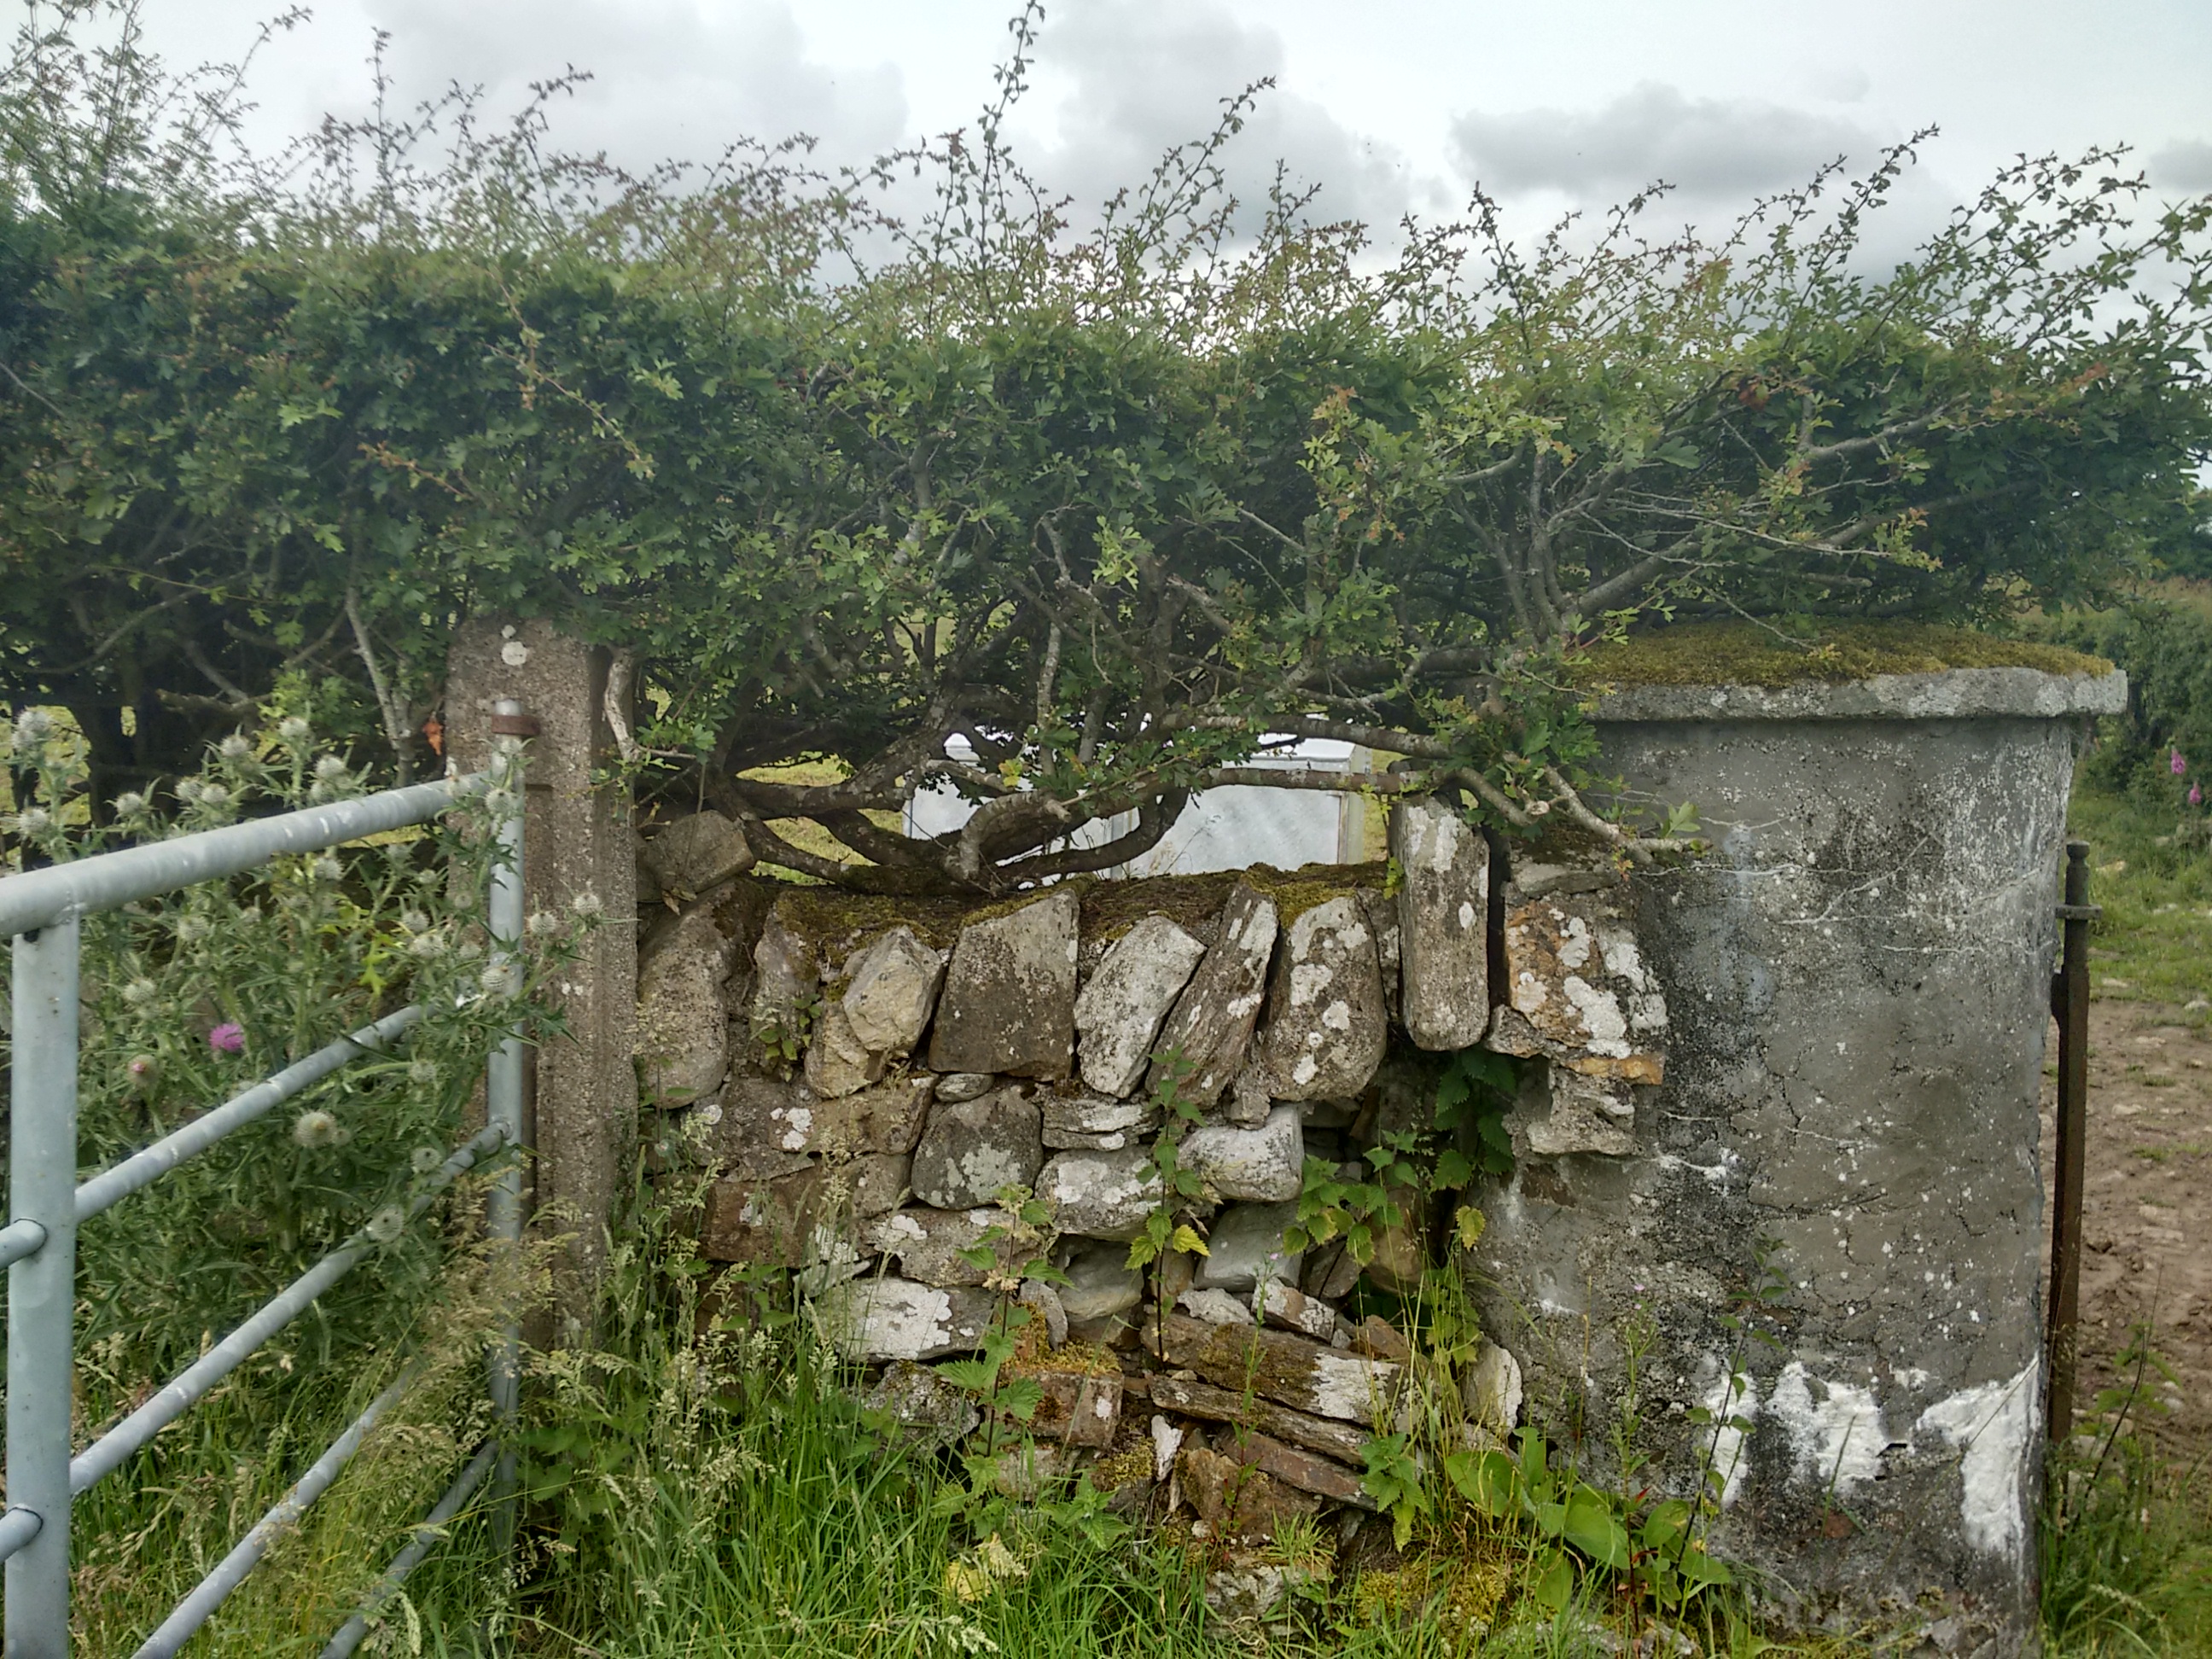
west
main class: Grassland
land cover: Grassland without tree/shrub cover
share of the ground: > 75 %
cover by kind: herbaceous plants 100 %
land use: Agriculture (excluding fallow land and kitchen gardens)
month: July
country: GB
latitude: 54.9034
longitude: -7.1902
